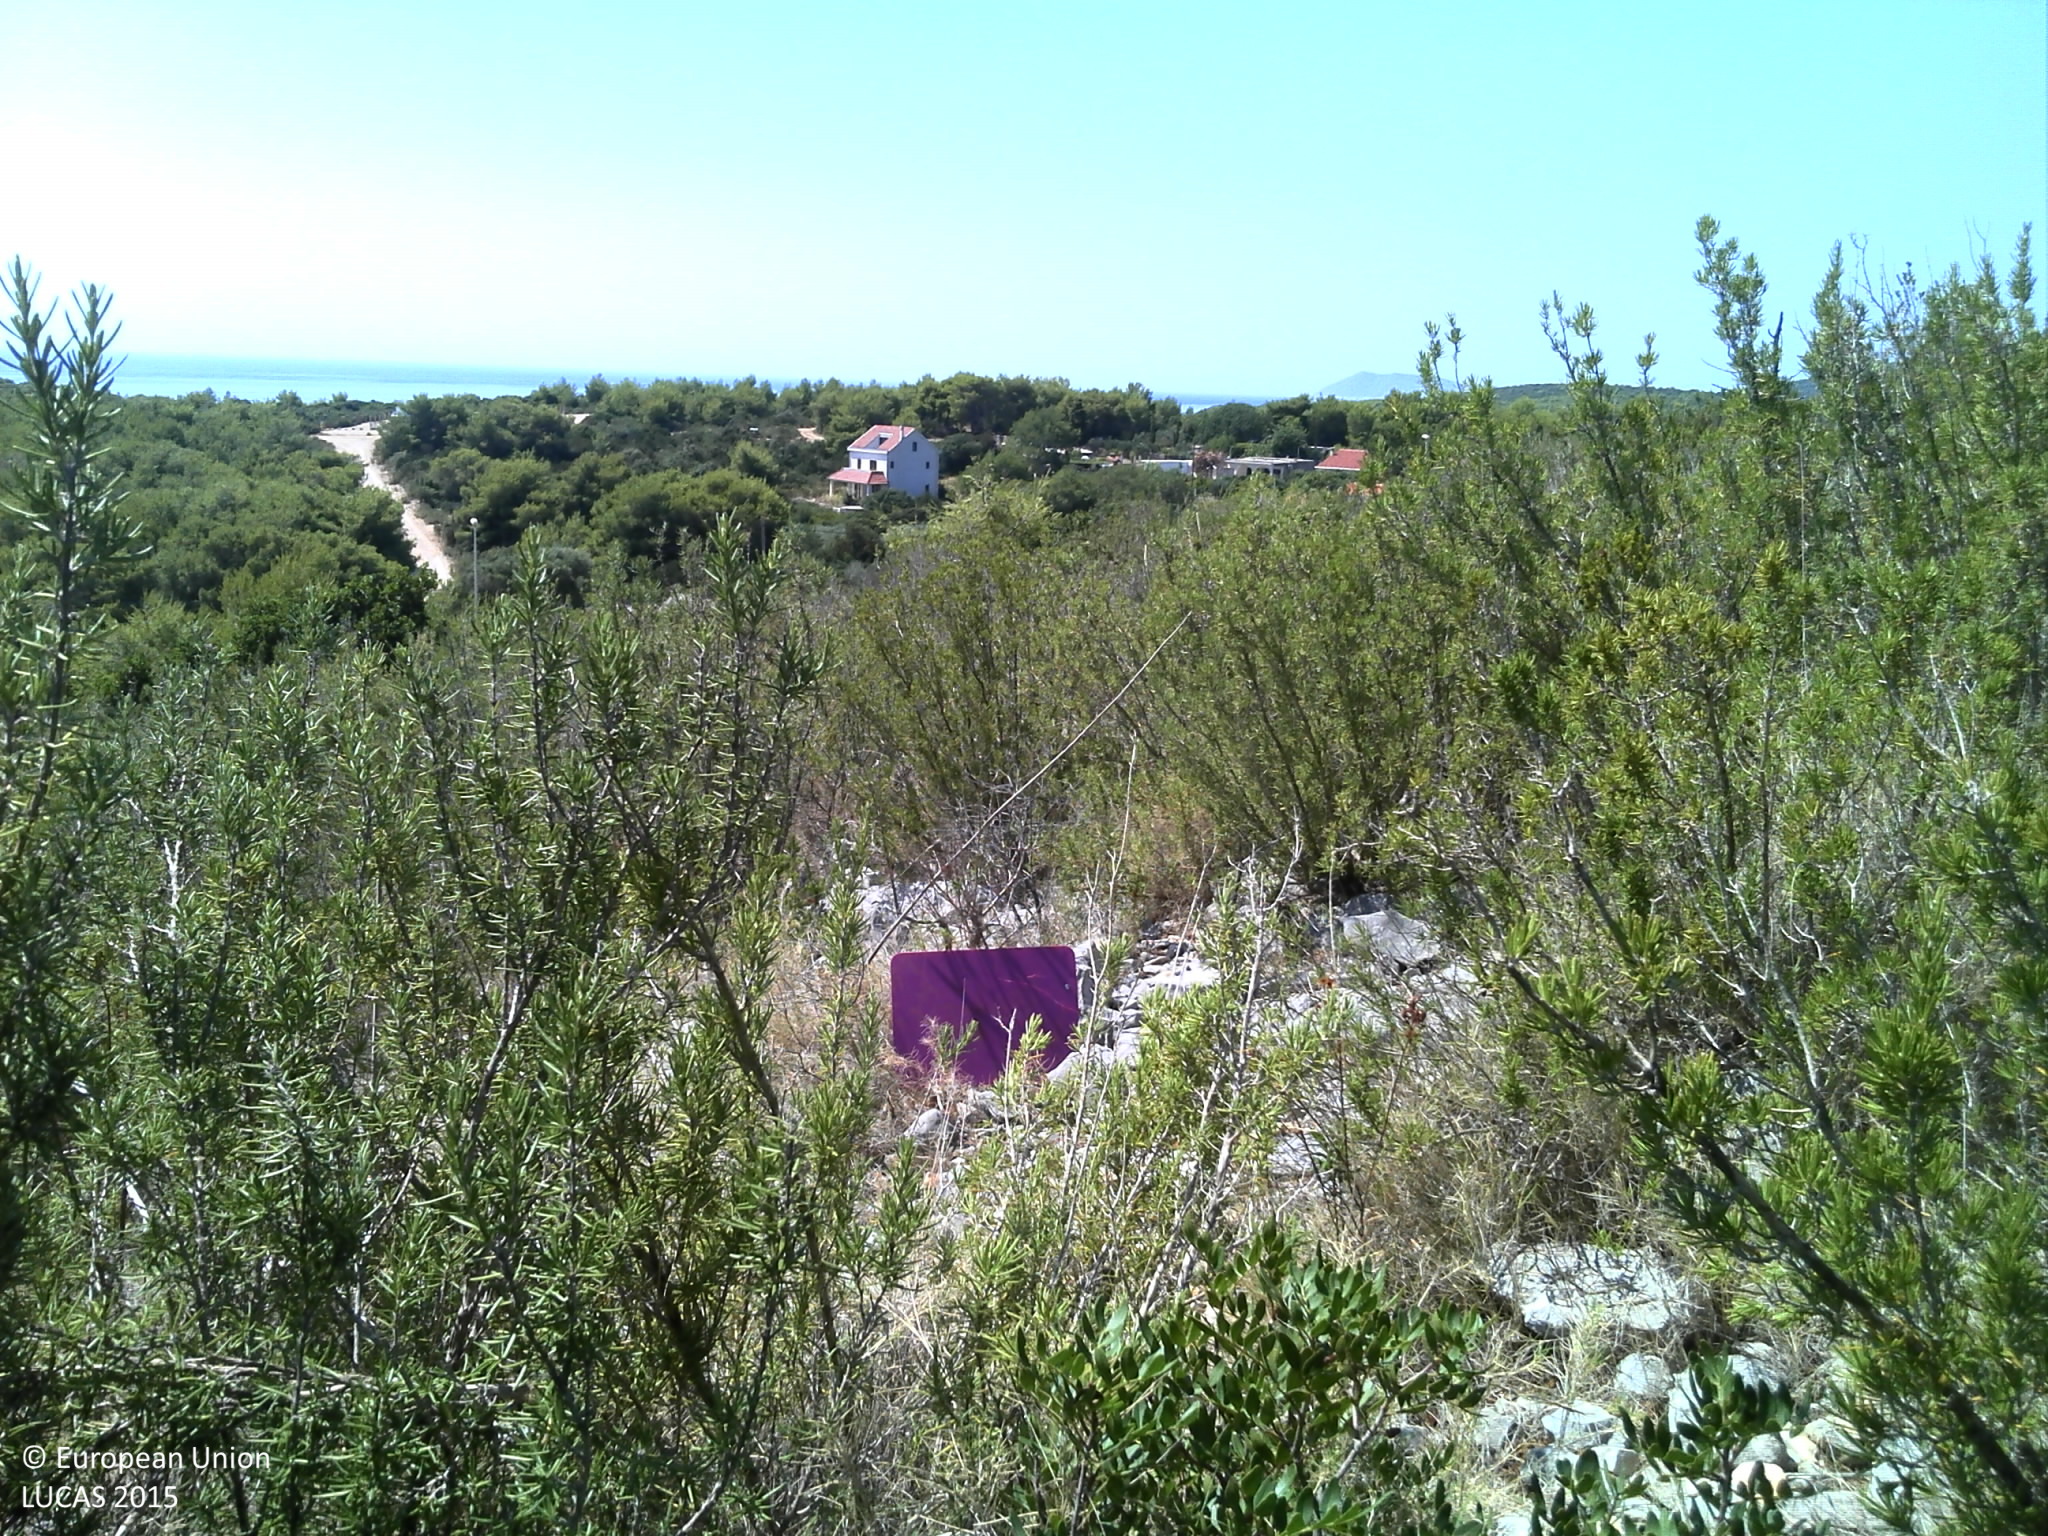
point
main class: Shrubland
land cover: Shrubland with sparse tree cover
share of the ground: > 75 %
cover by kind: shrubs 75 %, unconsolidated bare surface 10 %, coniferous forest trees 5 %, herbaceous plants 5 %, consolidated bare surface 5 %
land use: Semi-natural and natural areas not in use
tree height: > 5 m
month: August
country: HR
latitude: 43.0246
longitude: 16.2102
